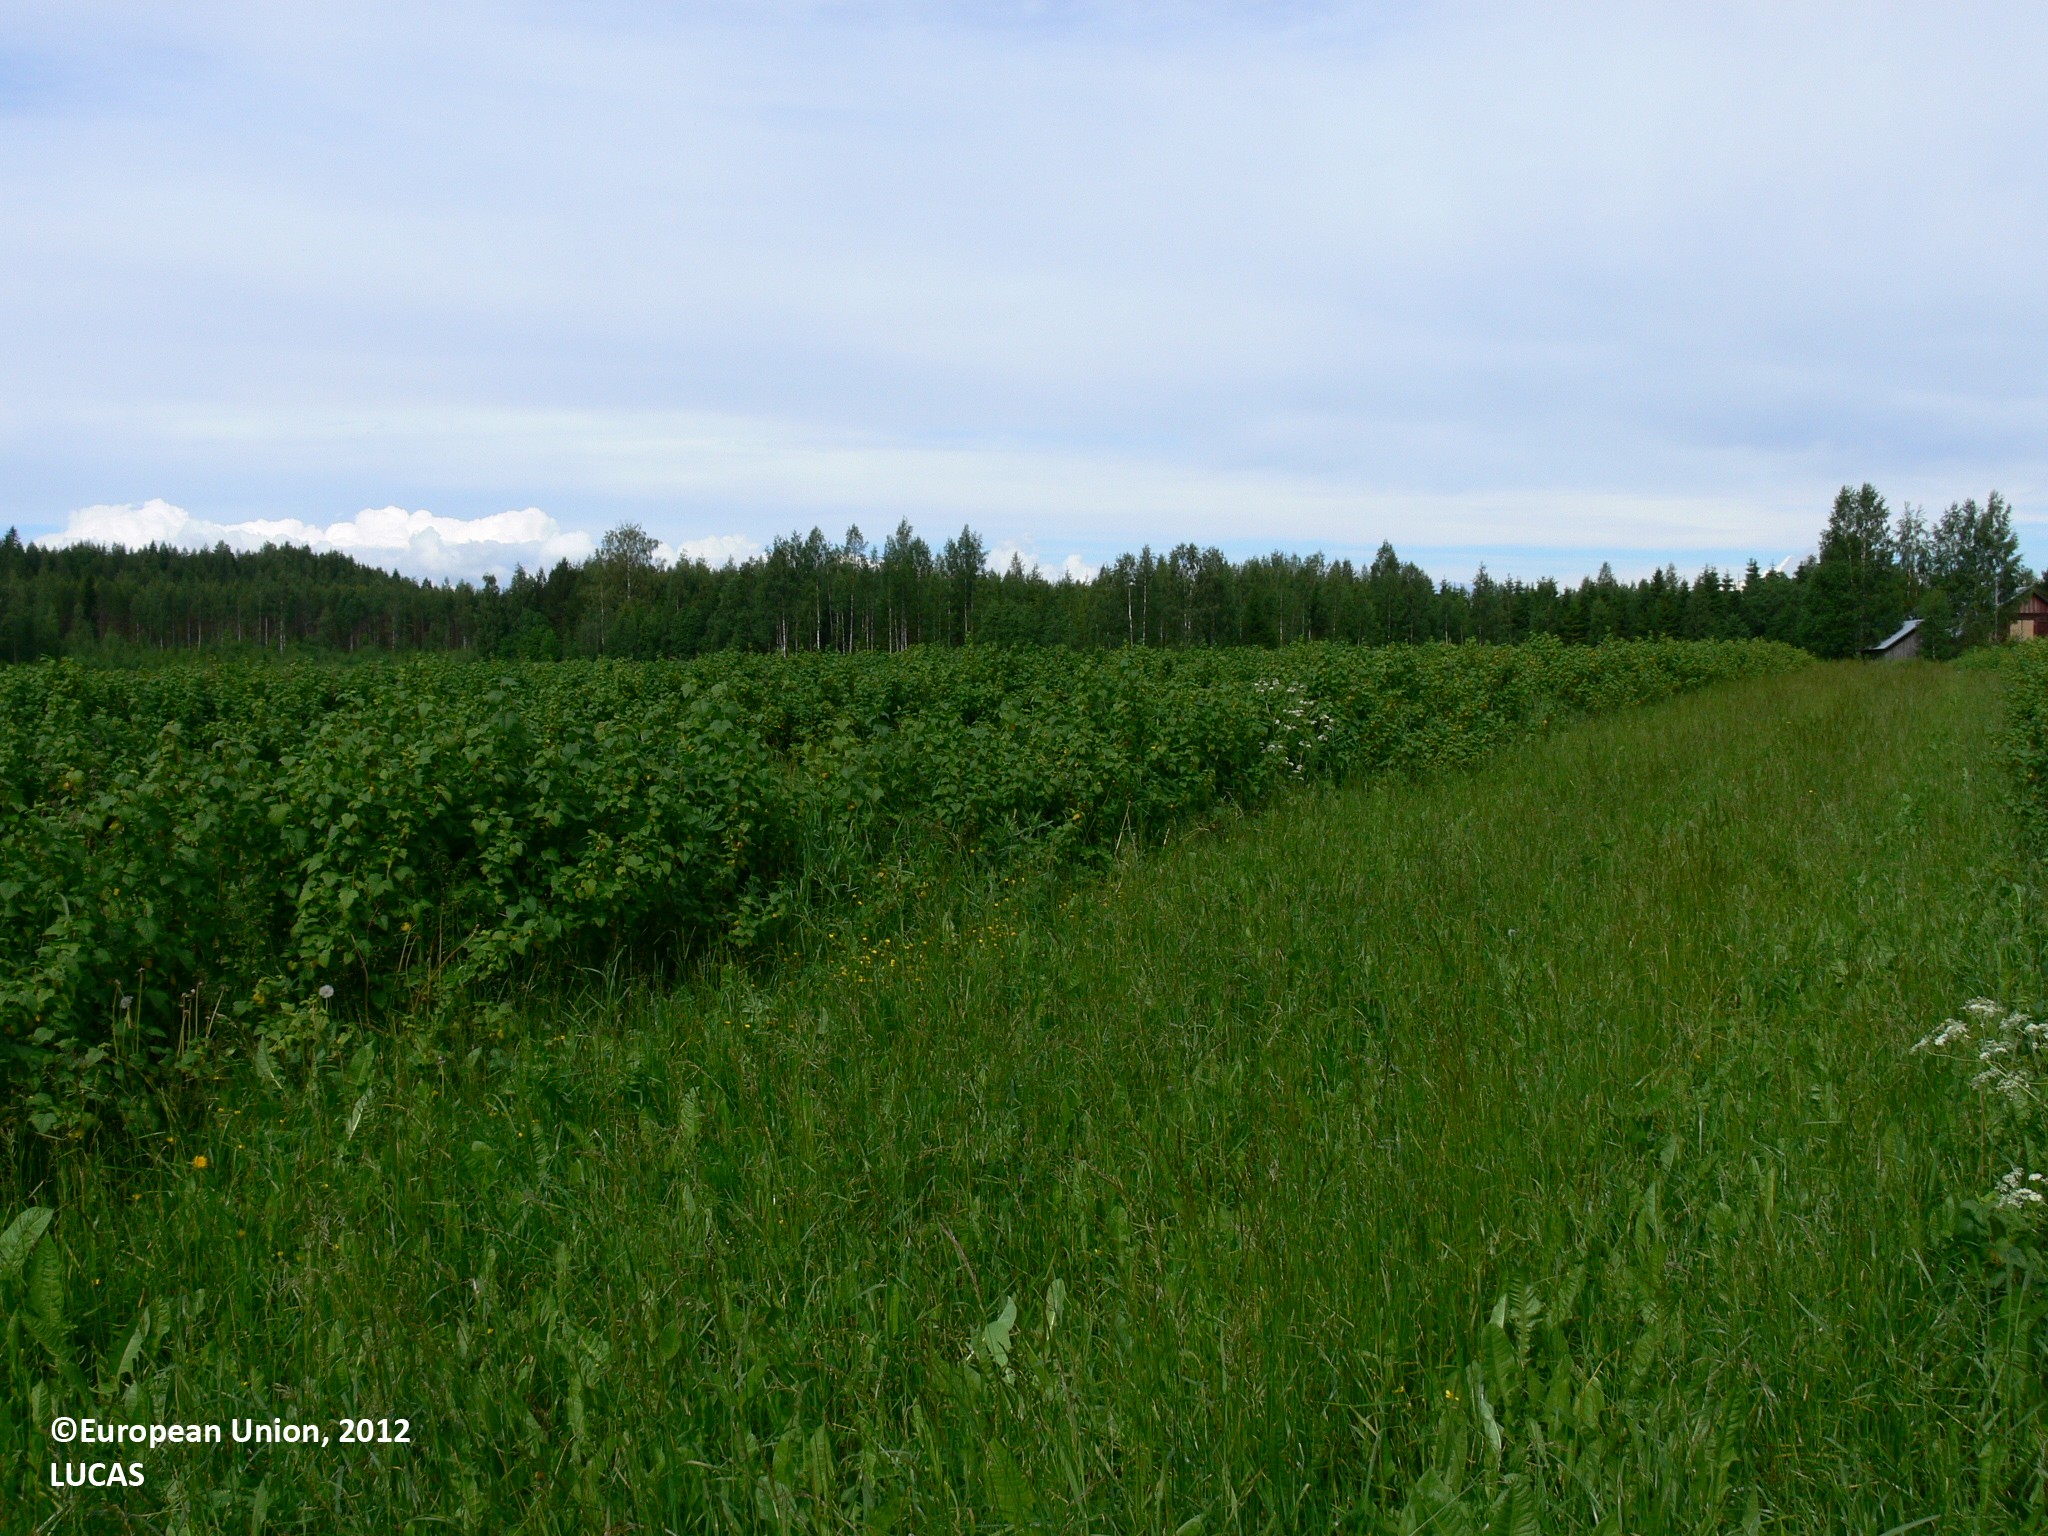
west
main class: Cropland
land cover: Other fruit trees and berries
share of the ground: 25 - 50 %
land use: Agriculture (excluding fallow land and kitchen gardens)
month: June
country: FI
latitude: 62.6445
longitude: 29.4908
